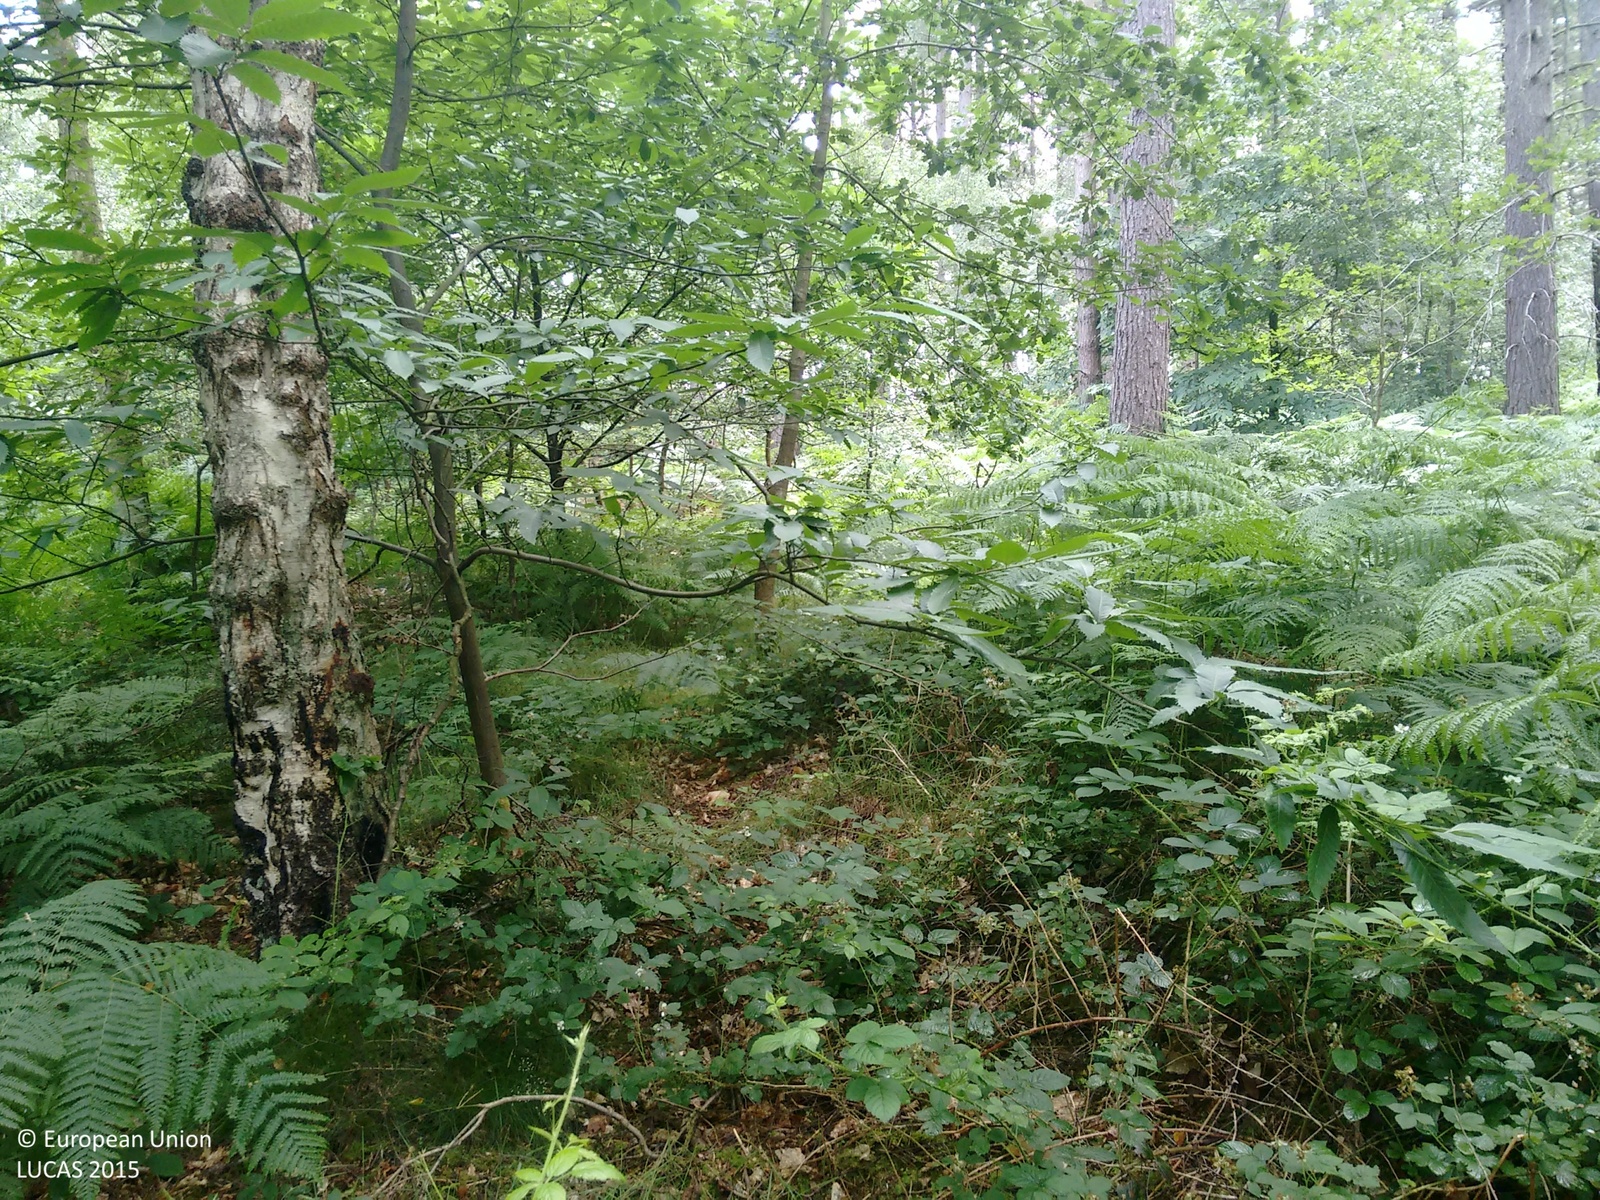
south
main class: Woodland
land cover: Spruce dominated coniferous woodland
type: exotic forest
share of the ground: > 75 %
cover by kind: coniferous forest trees 80 %, broadleaved forest trees 20 %
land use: Forestry
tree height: > 5 m
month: July
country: GB
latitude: 53.1446
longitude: -1.0935
